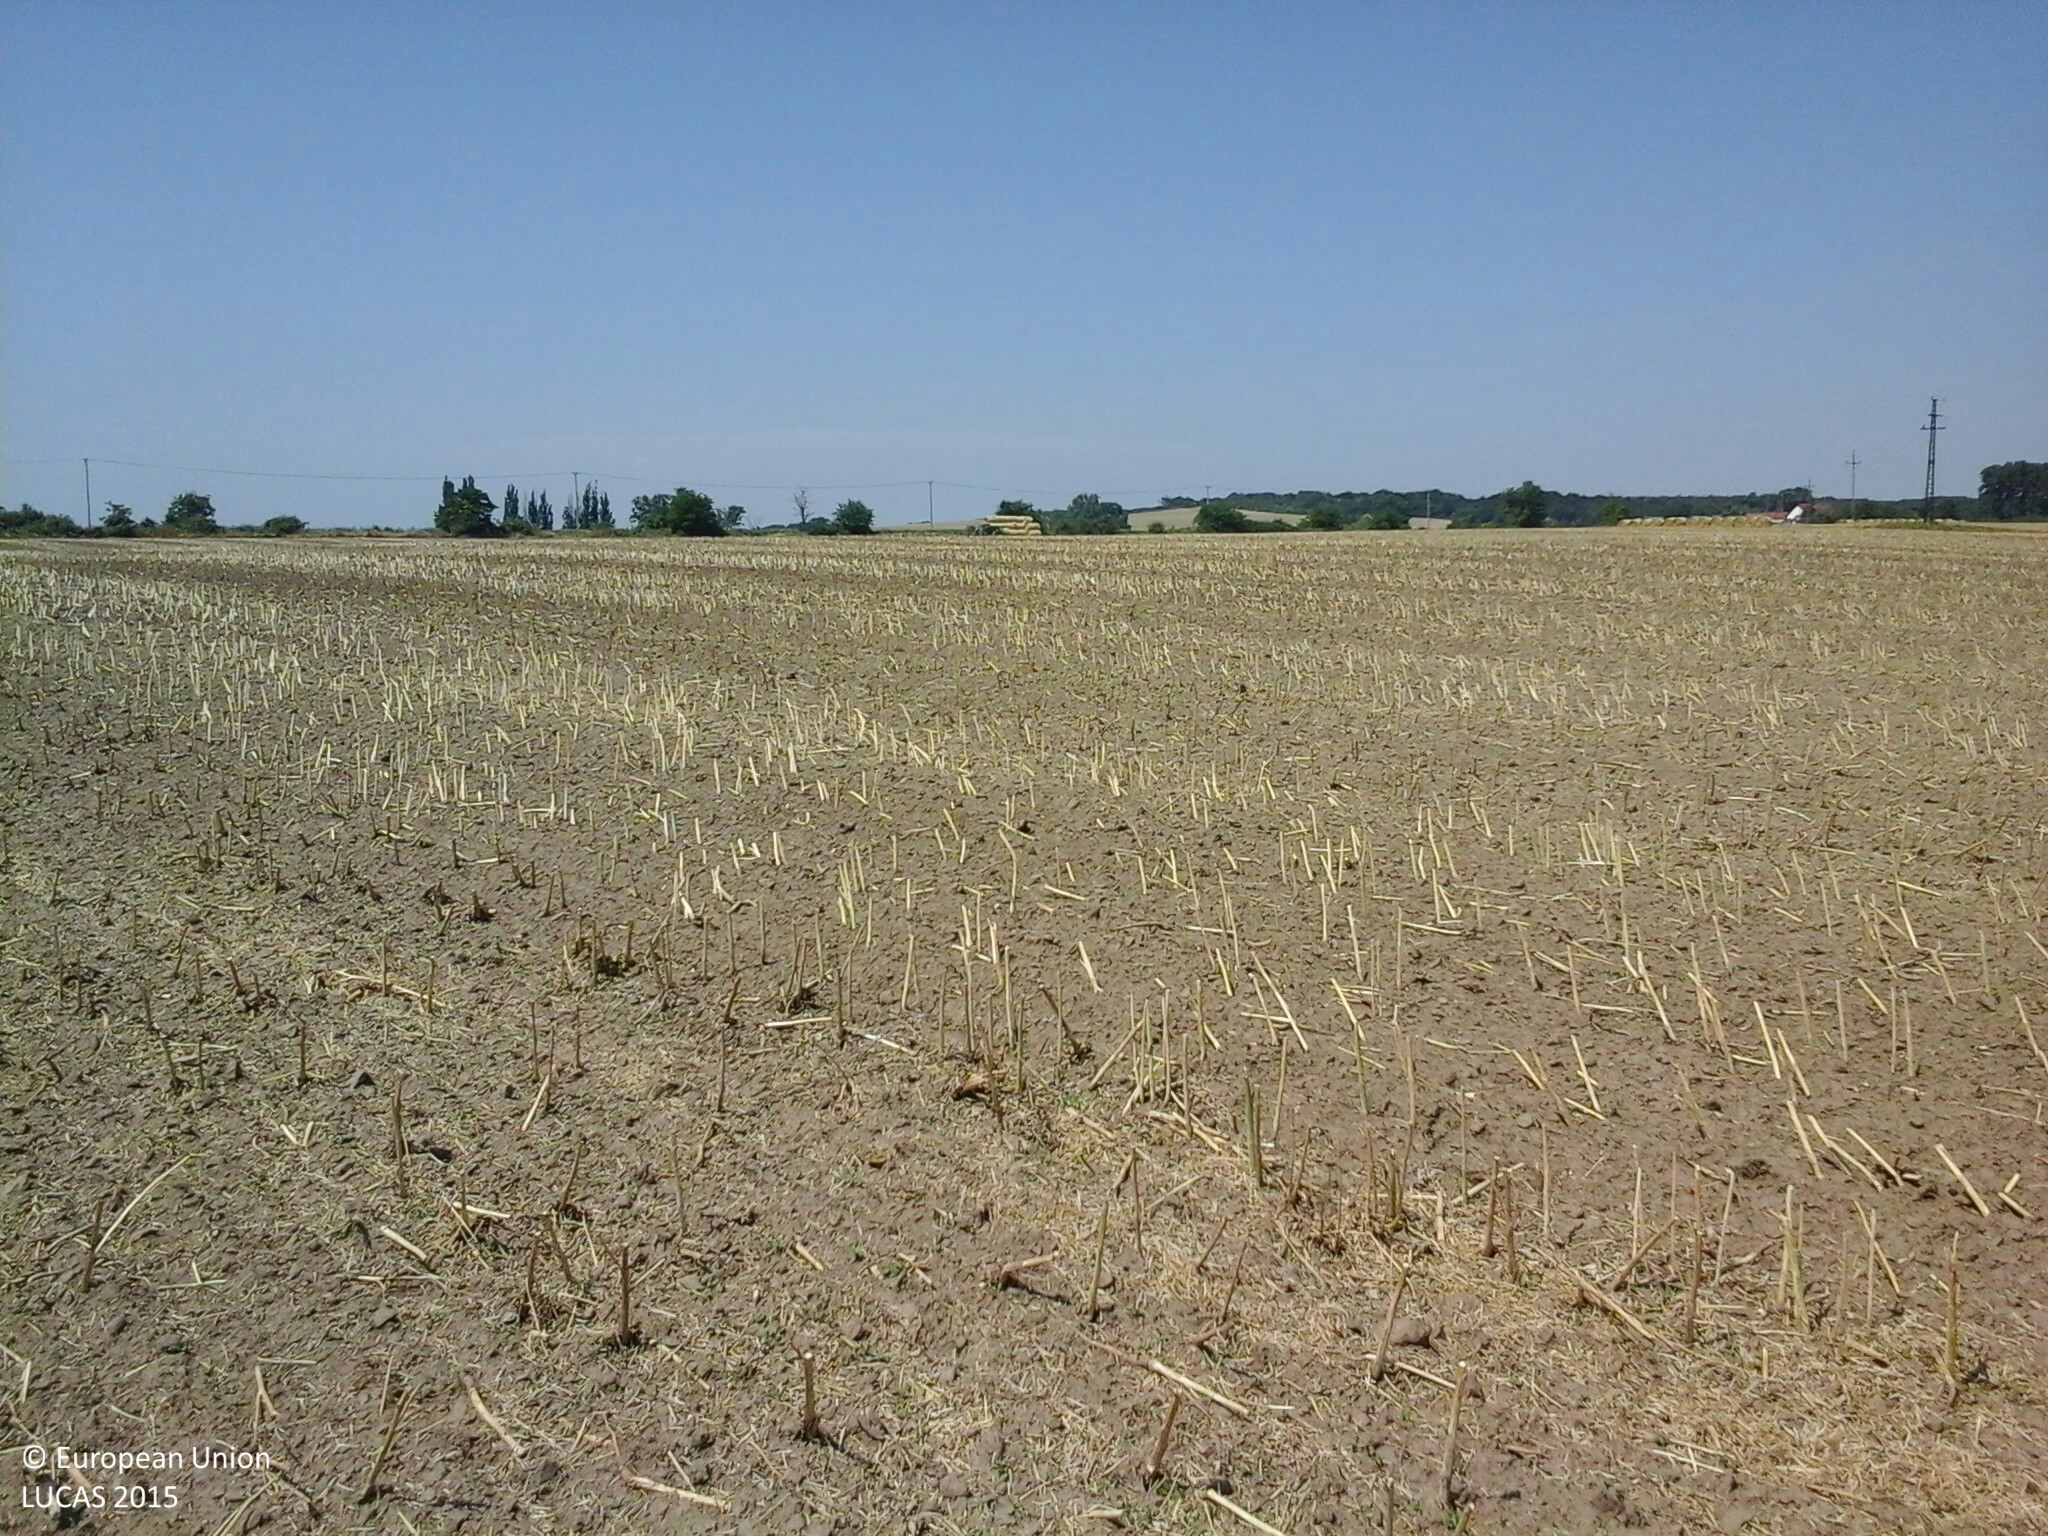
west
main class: Cropland
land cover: Rape and turnip rape
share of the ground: 10 - 25 %
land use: Agriculture (excluding fallow land and kitchen gardens)
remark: Harvested field
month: July
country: HU
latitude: 47.3306
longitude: 18.3090
